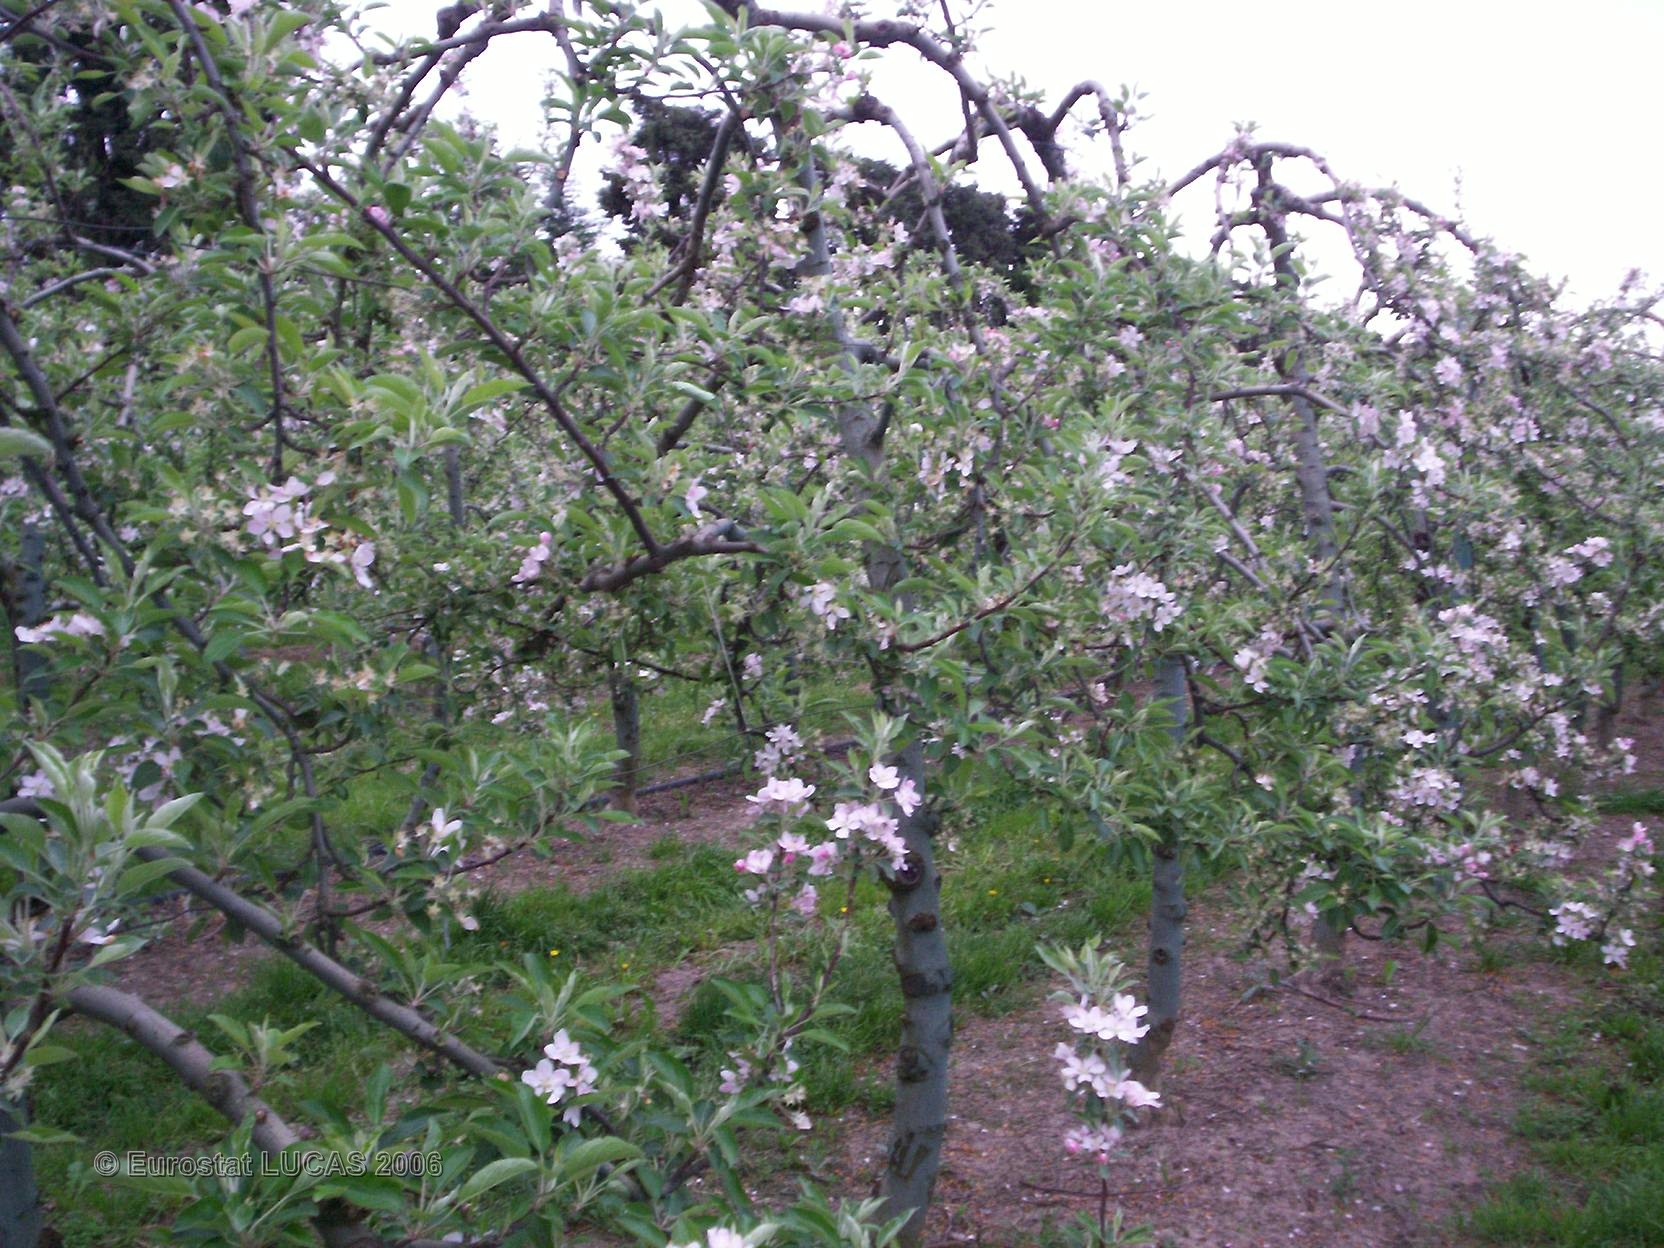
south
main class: Cropland
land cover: Apple fruit
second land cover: Grassland with sparse tree/shrub cover
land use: Agriculture (excluding fallow land and kitchen gardens)
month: April
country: FR
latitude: 43.8647
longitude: 4.9198
